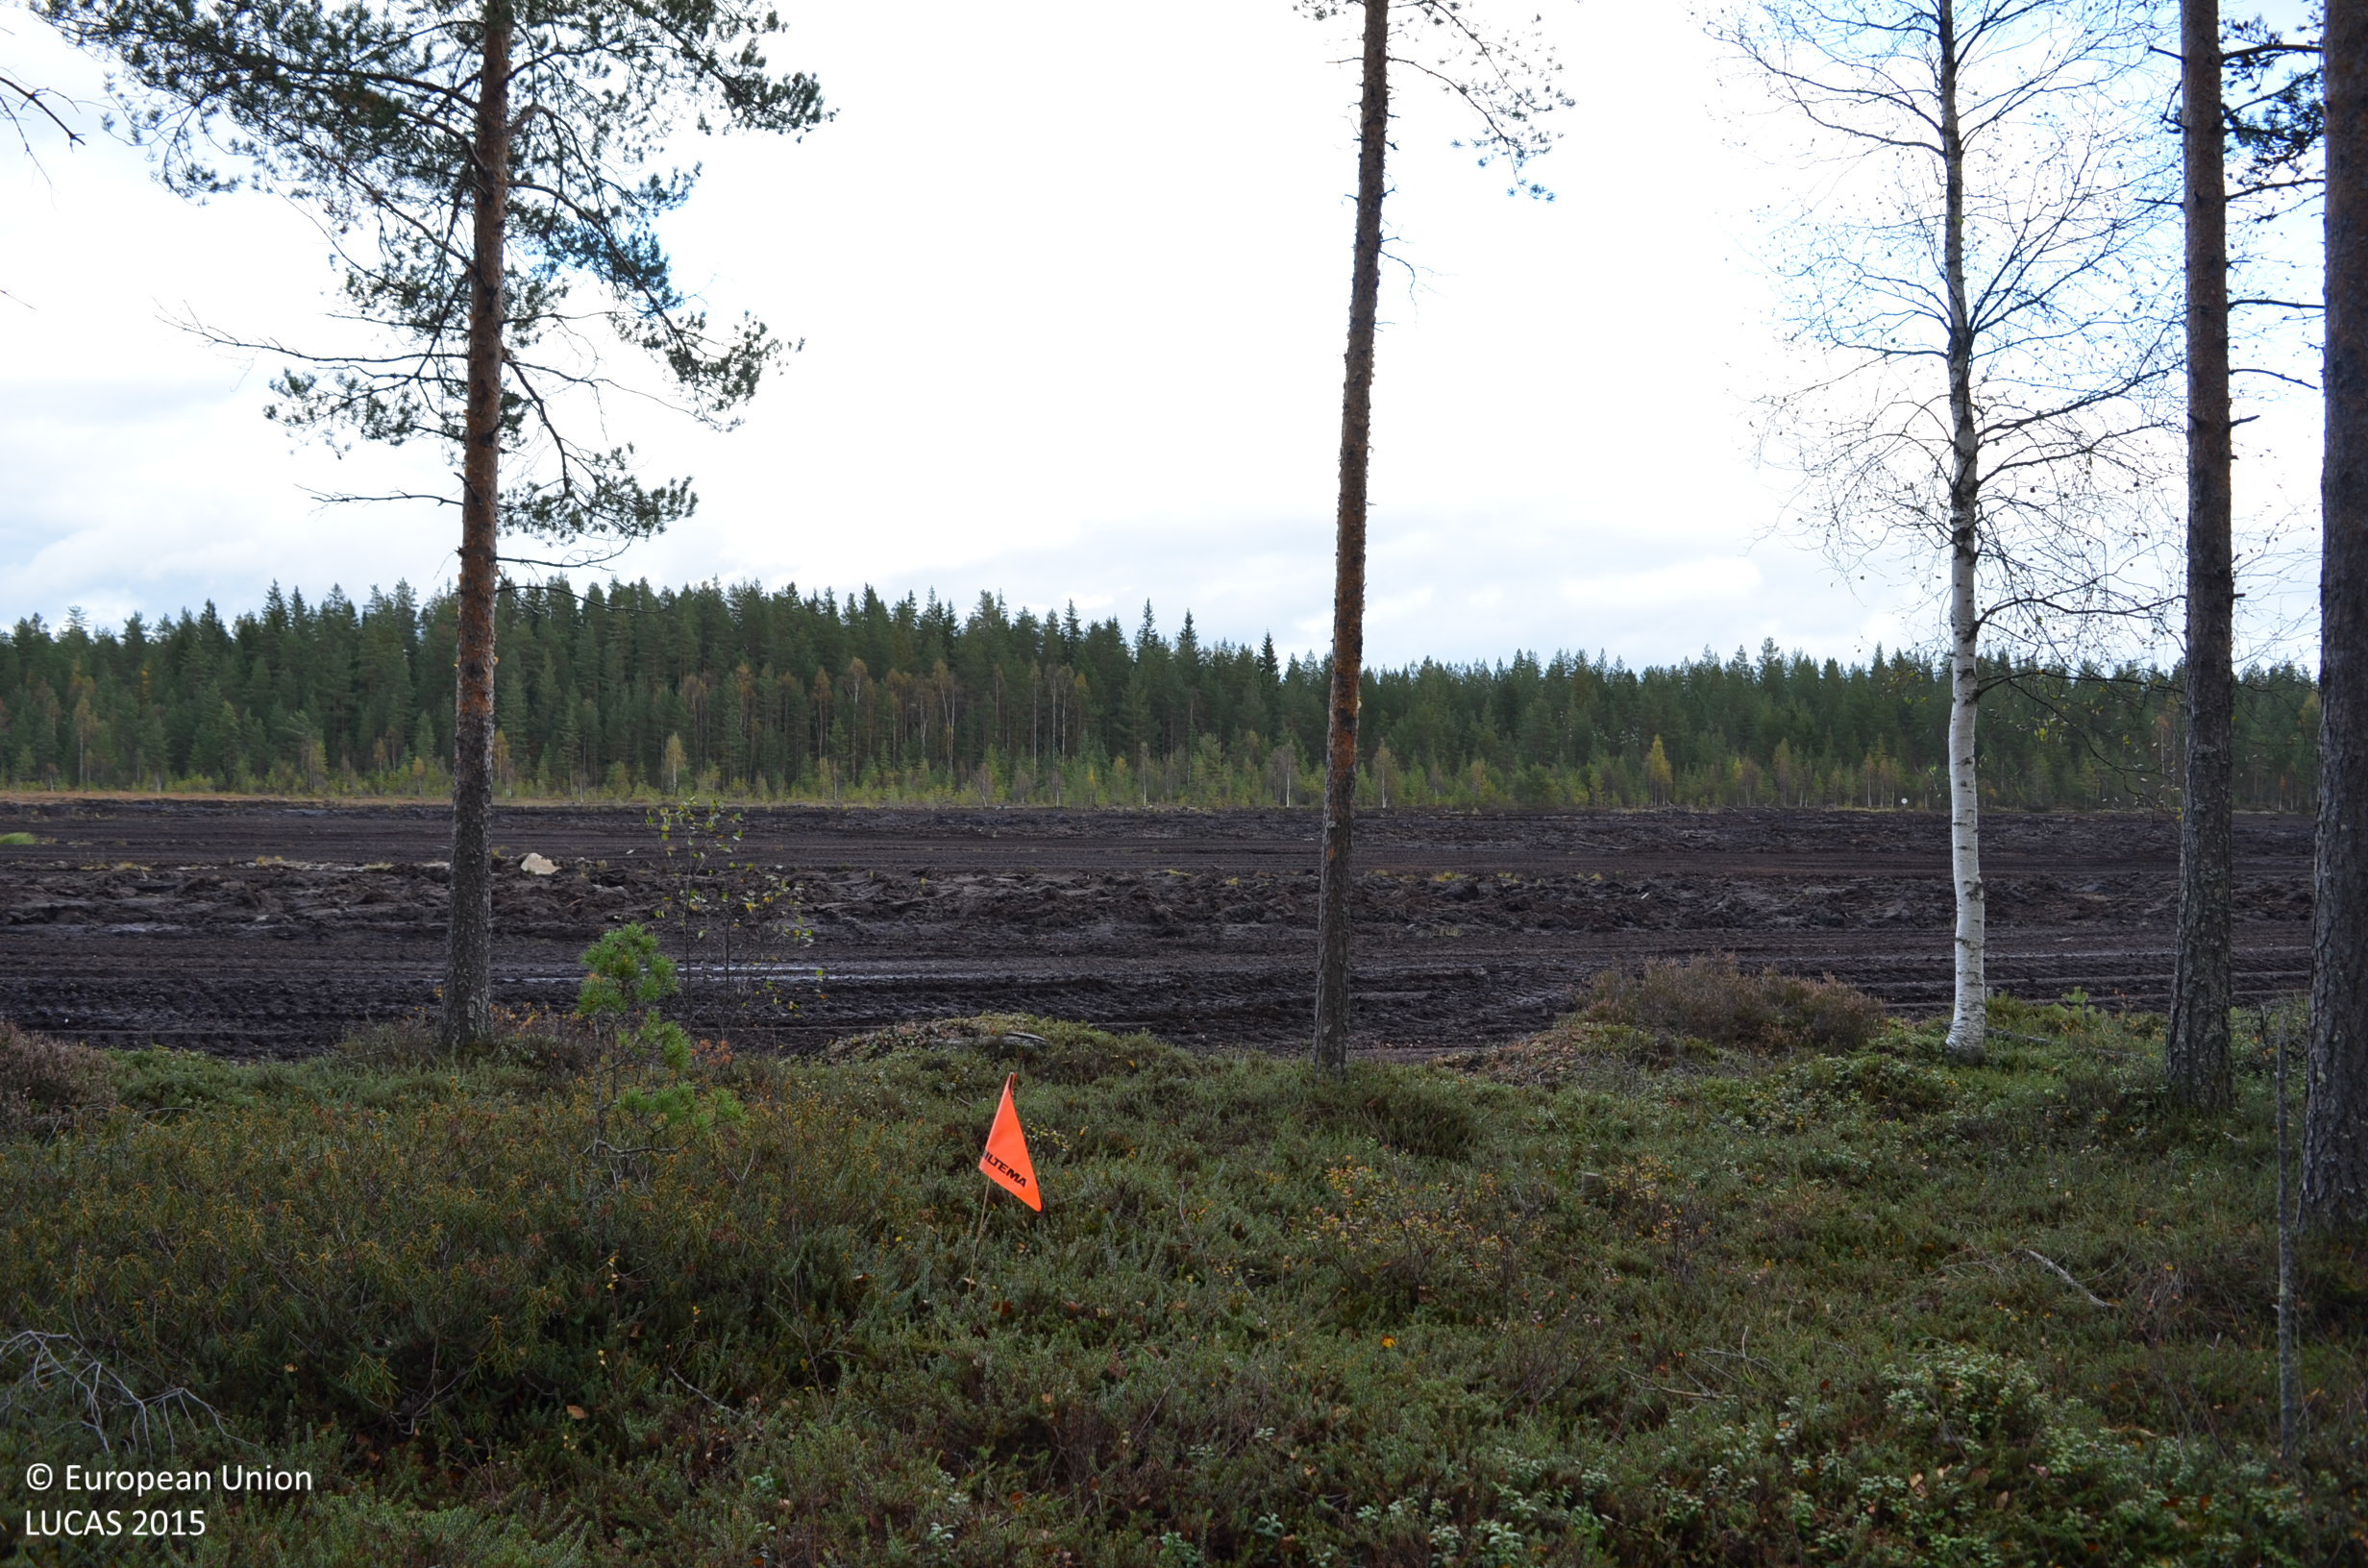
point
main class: Woodland
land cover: Pine dominated mixed woodland
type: boreal forest
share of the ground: 50 - 75 %
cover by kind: coniferous forest trees 40 %, broadleaved forest trees 30 %, shrubs 30 %
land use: Forestry
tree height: > 5 m
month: September
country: FI
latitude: 62.4906
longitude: 23.5597
